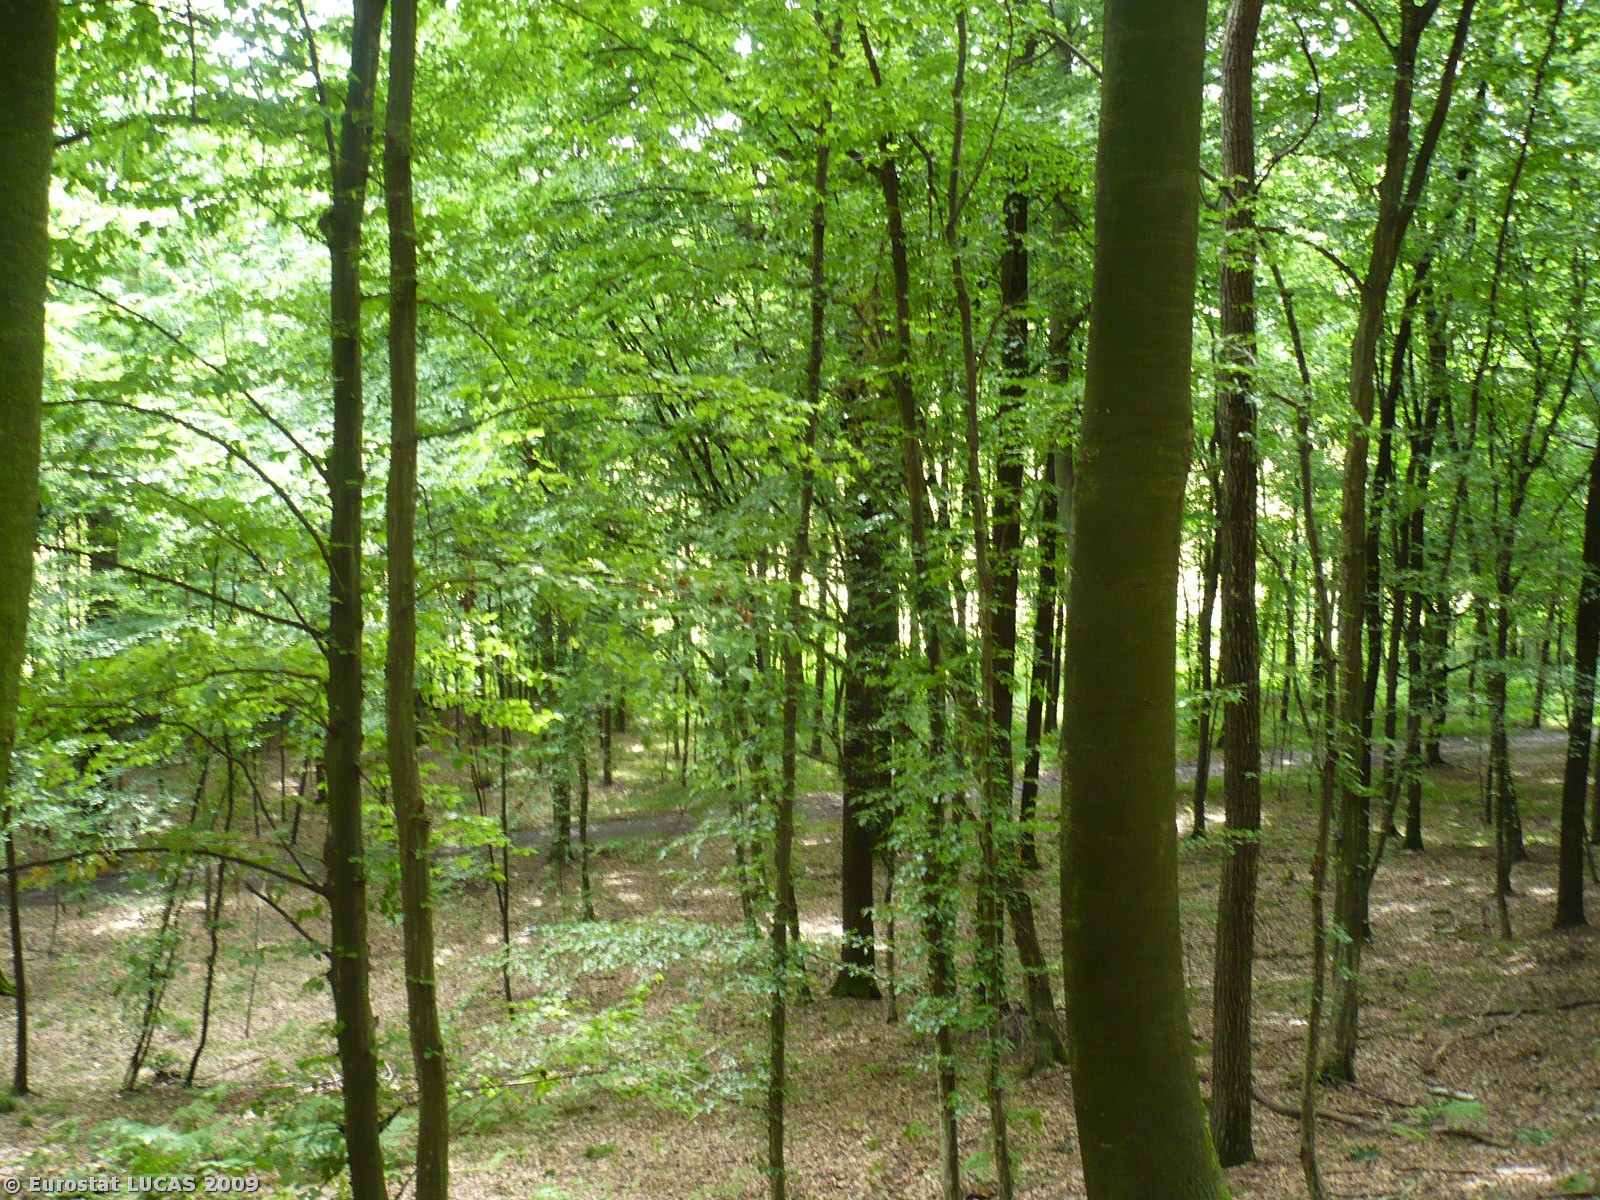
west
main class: Woodland
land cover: Broadleaved woodland
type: mesophytic deciduous forest
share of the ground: > 75 %
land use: Forestry
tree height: > 5 m
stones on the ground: < 10 %
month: June
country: SI
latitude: 46.5777
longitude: 16.0417
